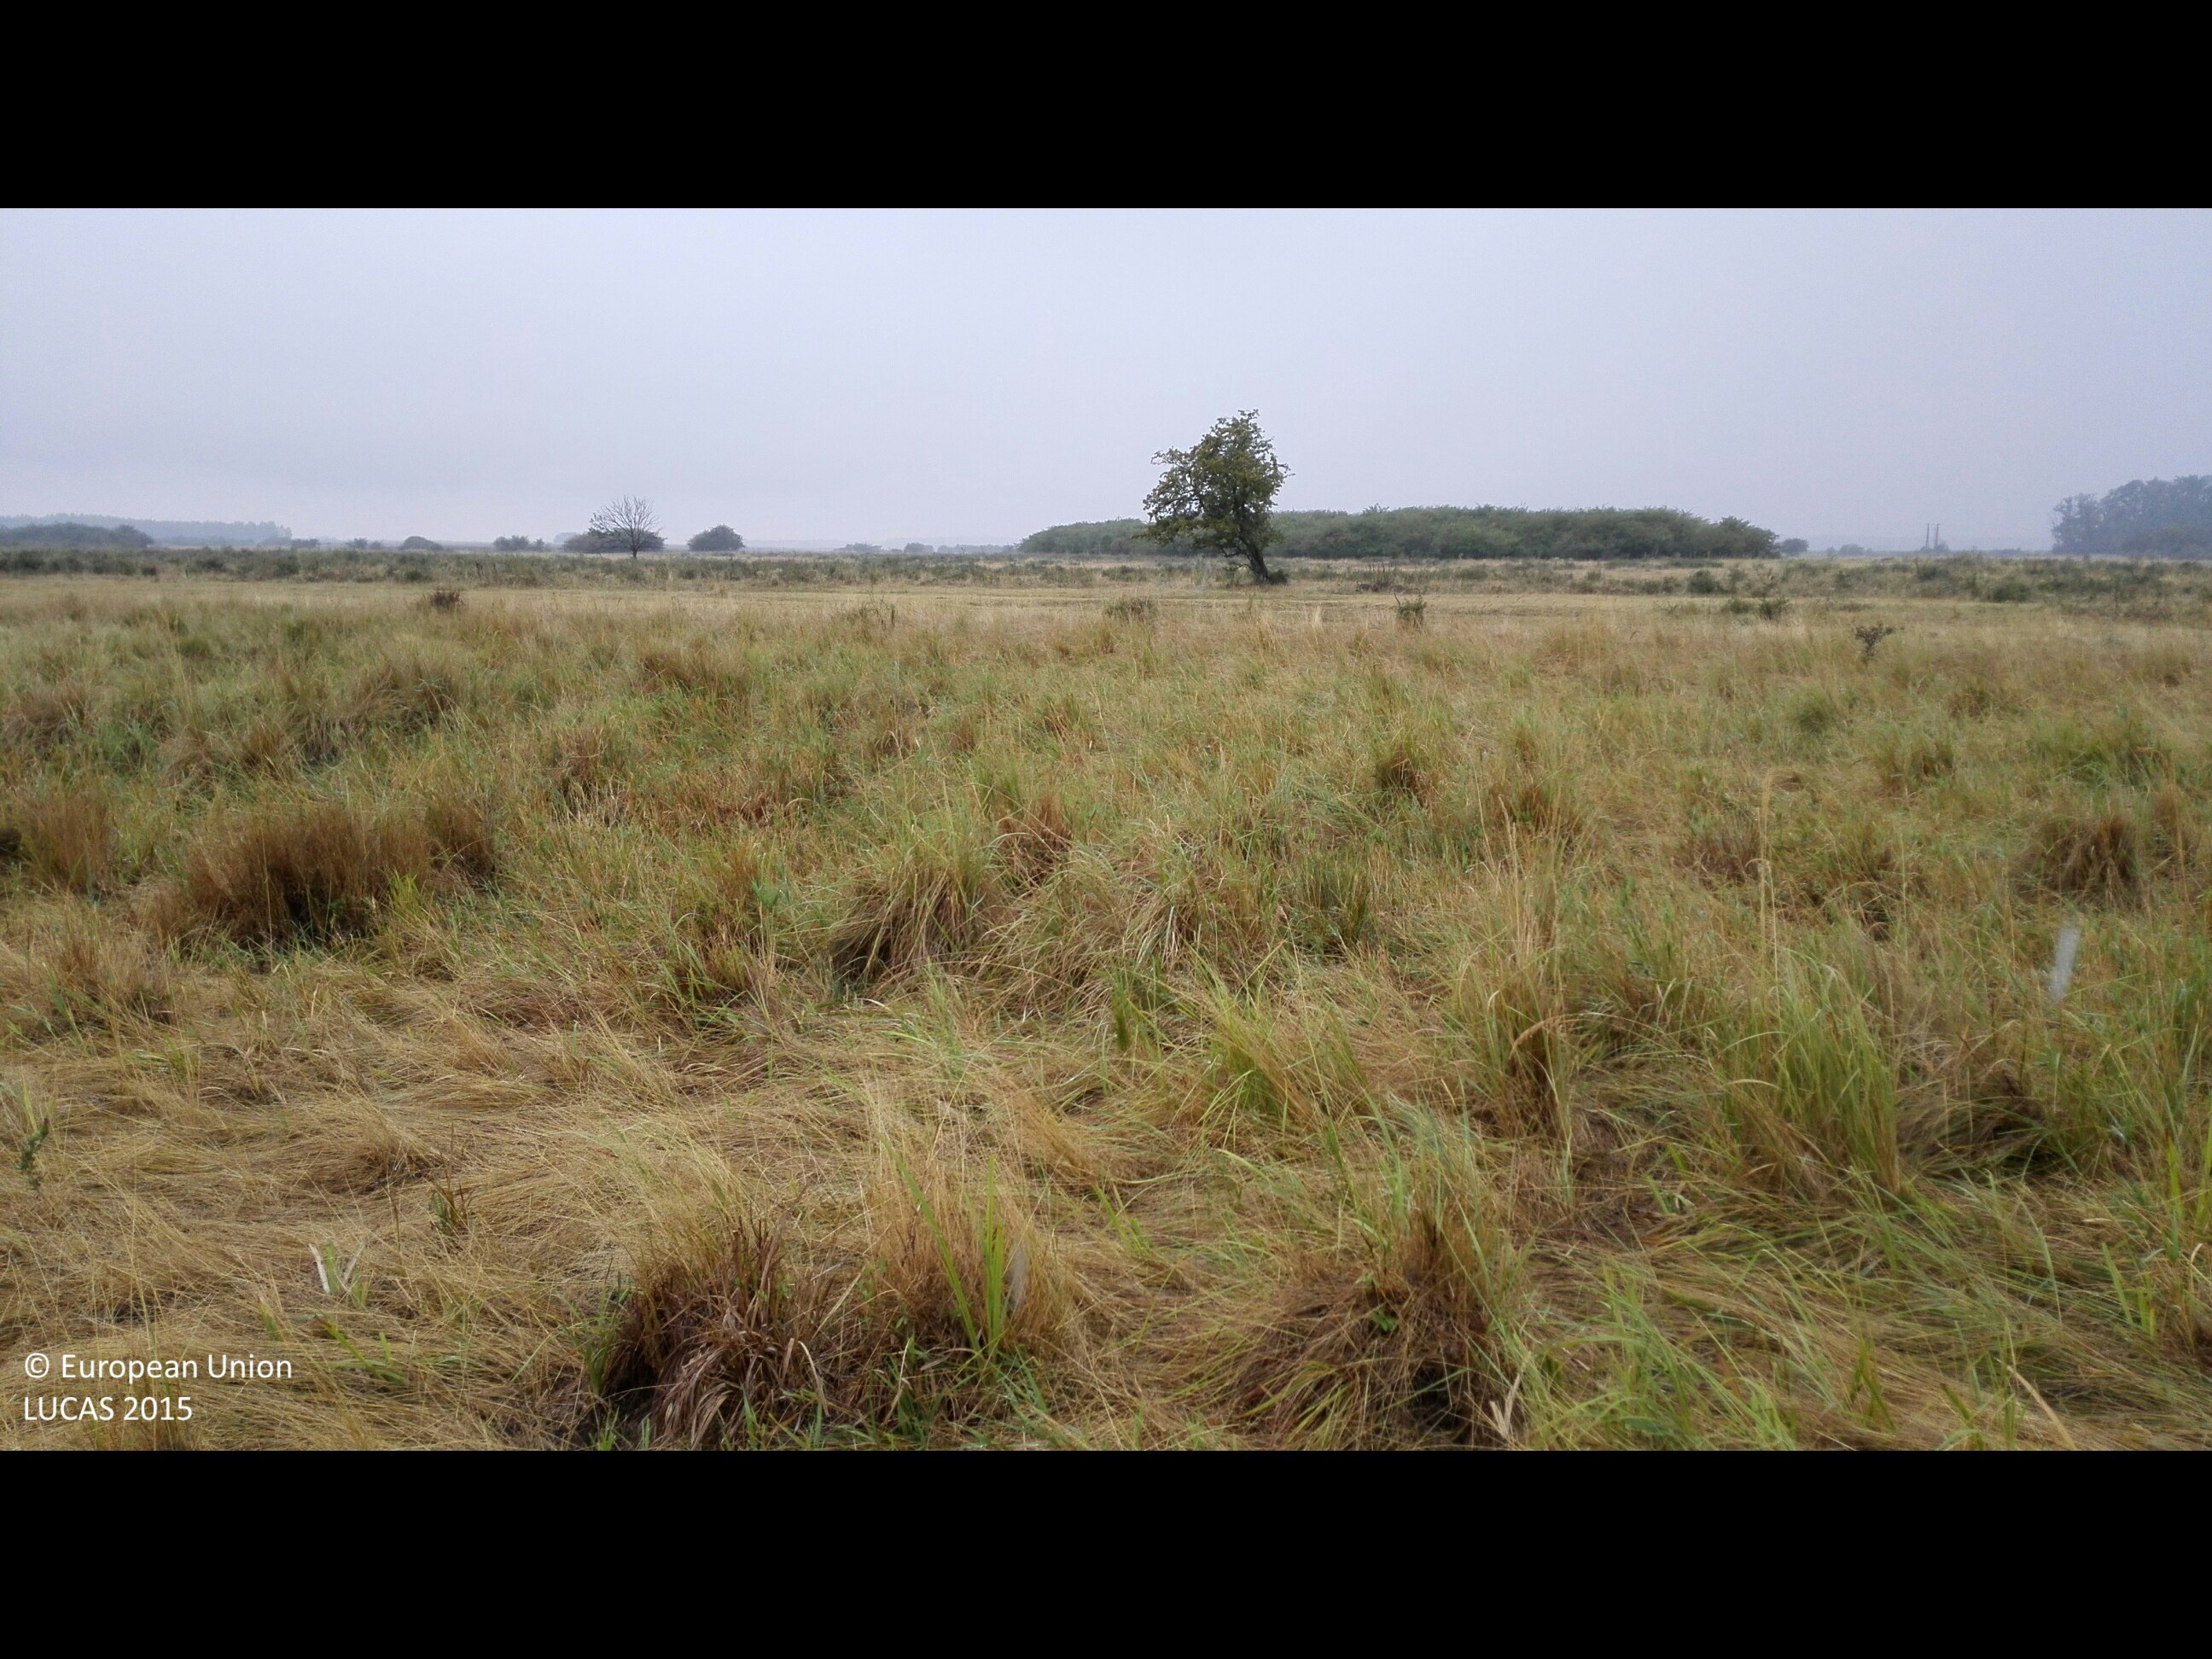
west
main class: Grassland
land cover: Grassland without tree/shrub cover
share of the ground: > 75 %
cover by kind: herbaceous plants 100 %
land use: Agriculture (excluding fallow land and kitchen gardens)
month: August
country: HU
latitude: 47.2697
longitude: 21.8765
